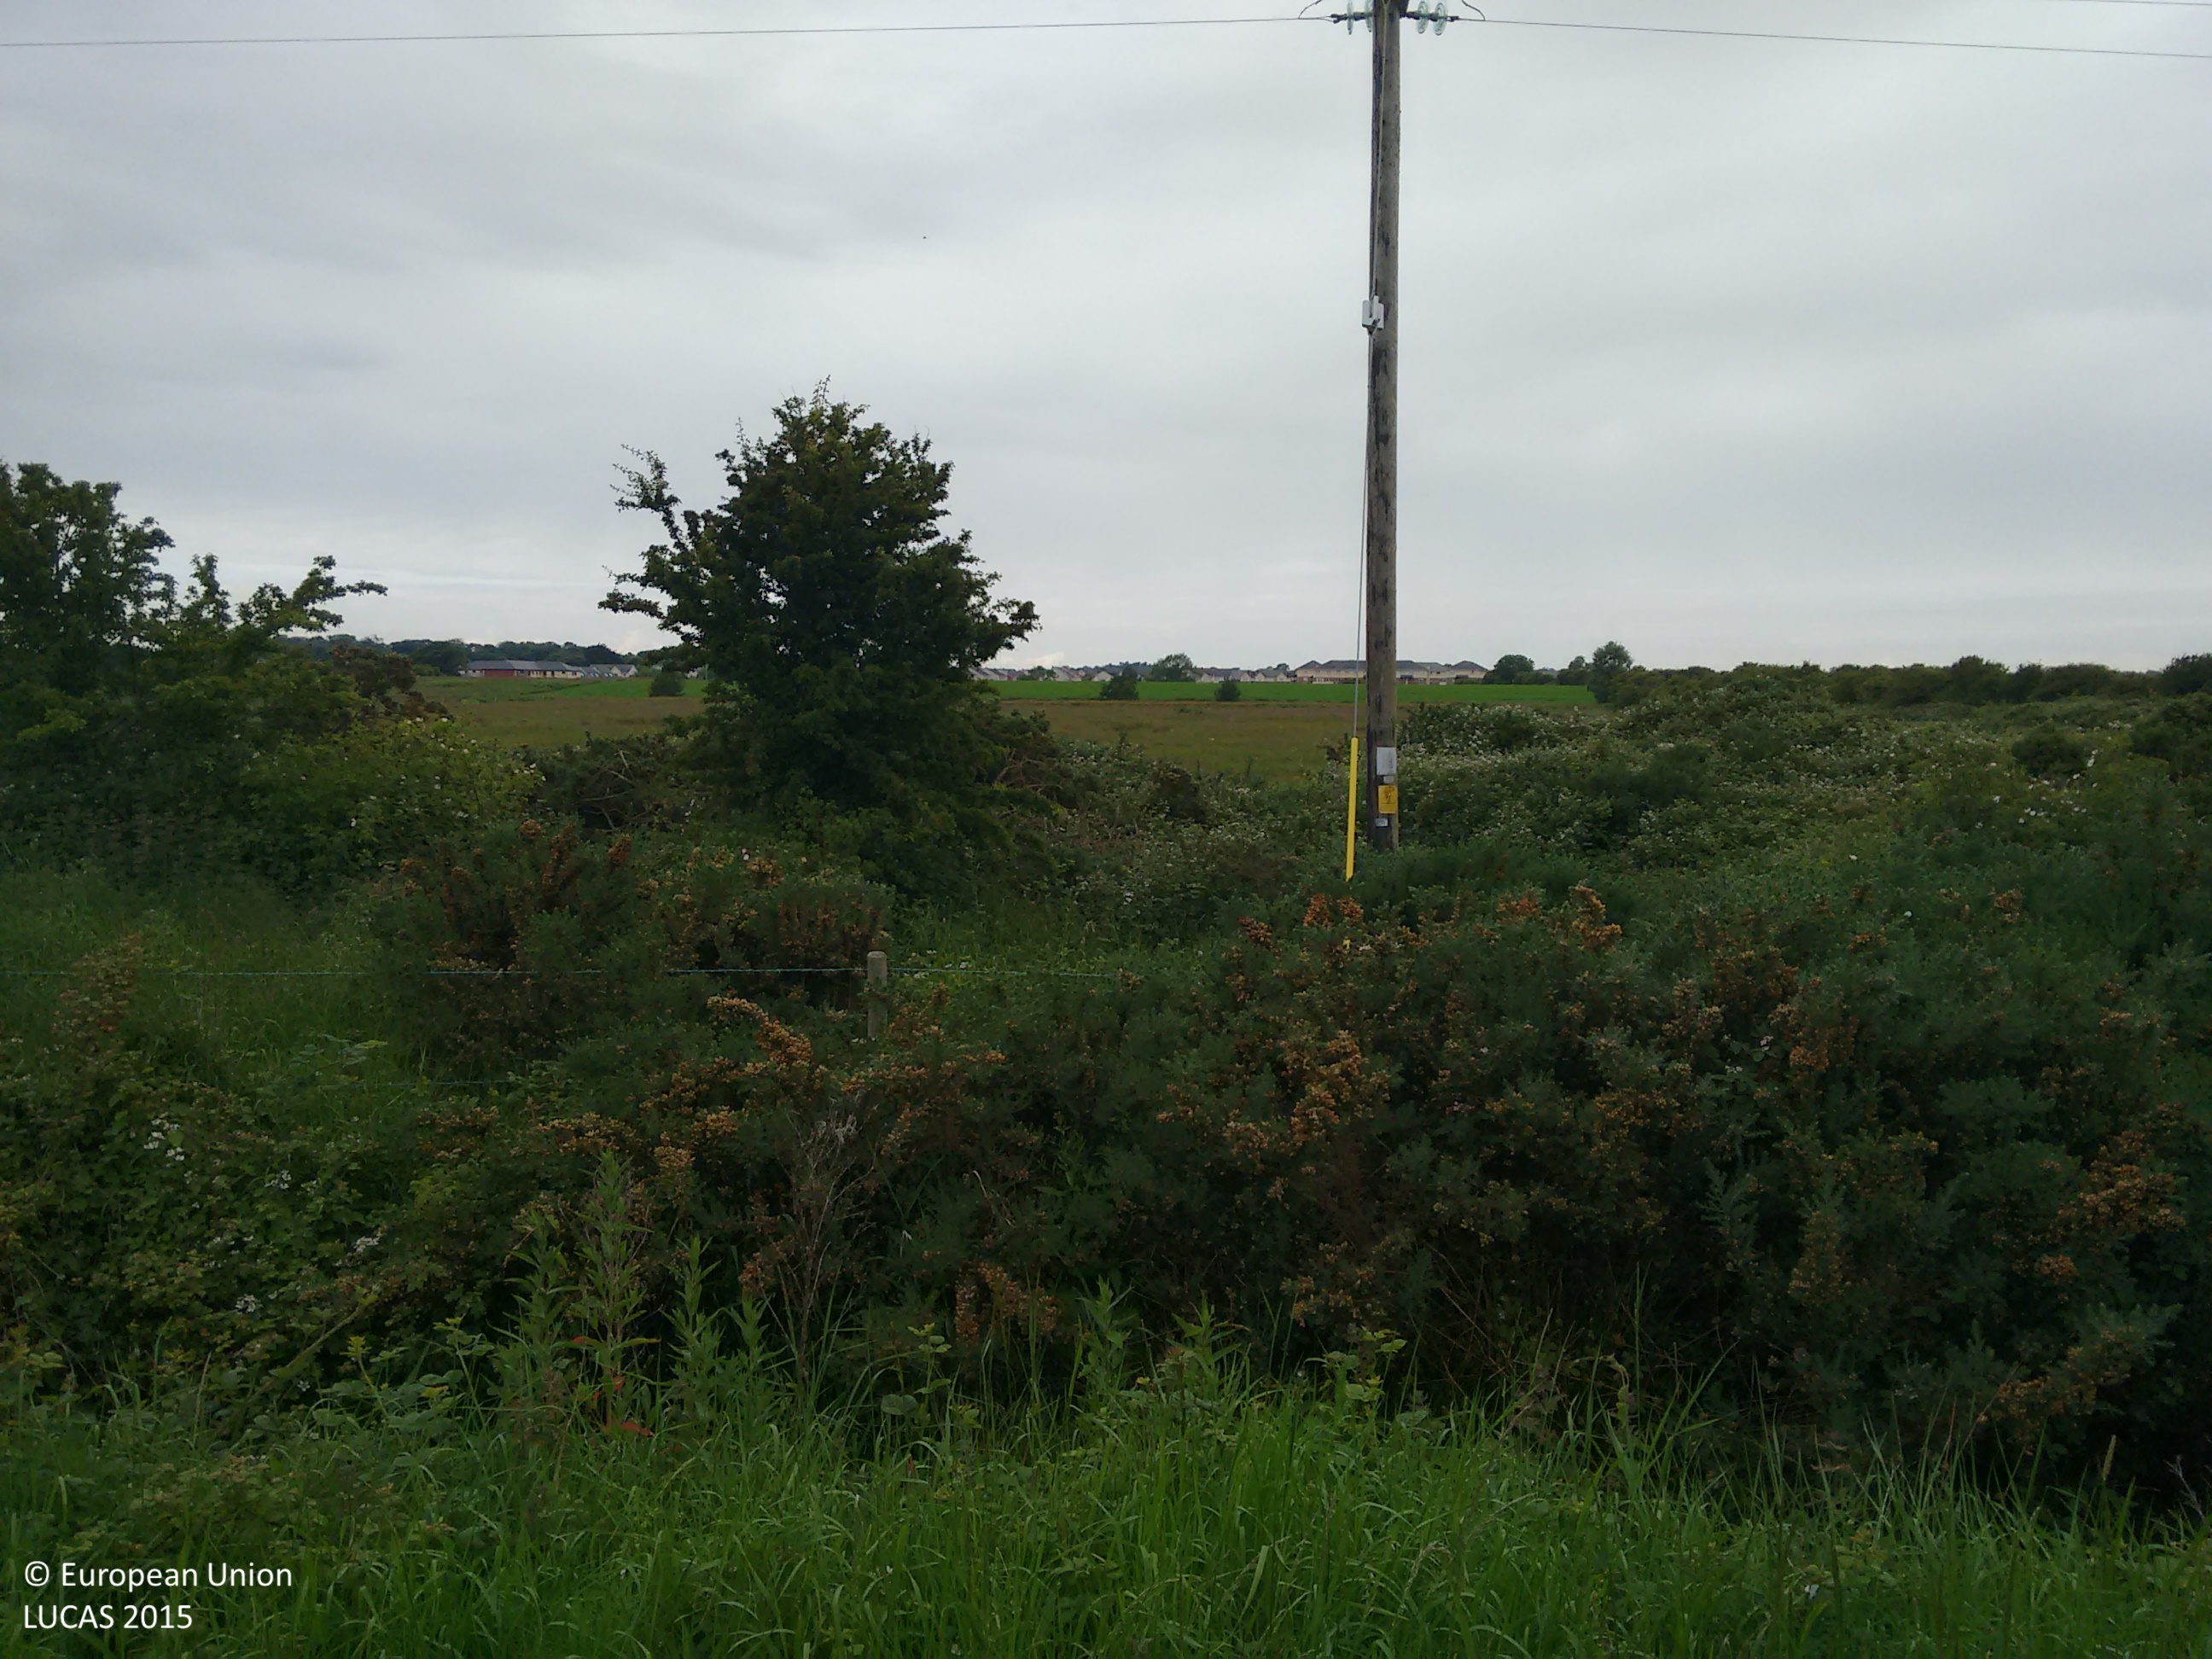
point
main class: Grassland
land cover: Grassland without tree/shrub cover
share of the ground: > 75 %
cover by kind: herbaceous plants 100 %
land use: Agriculture (excluding fallow land and kitchen gardens)
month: June
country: IE
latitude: 53.7074
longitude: -6.2533
